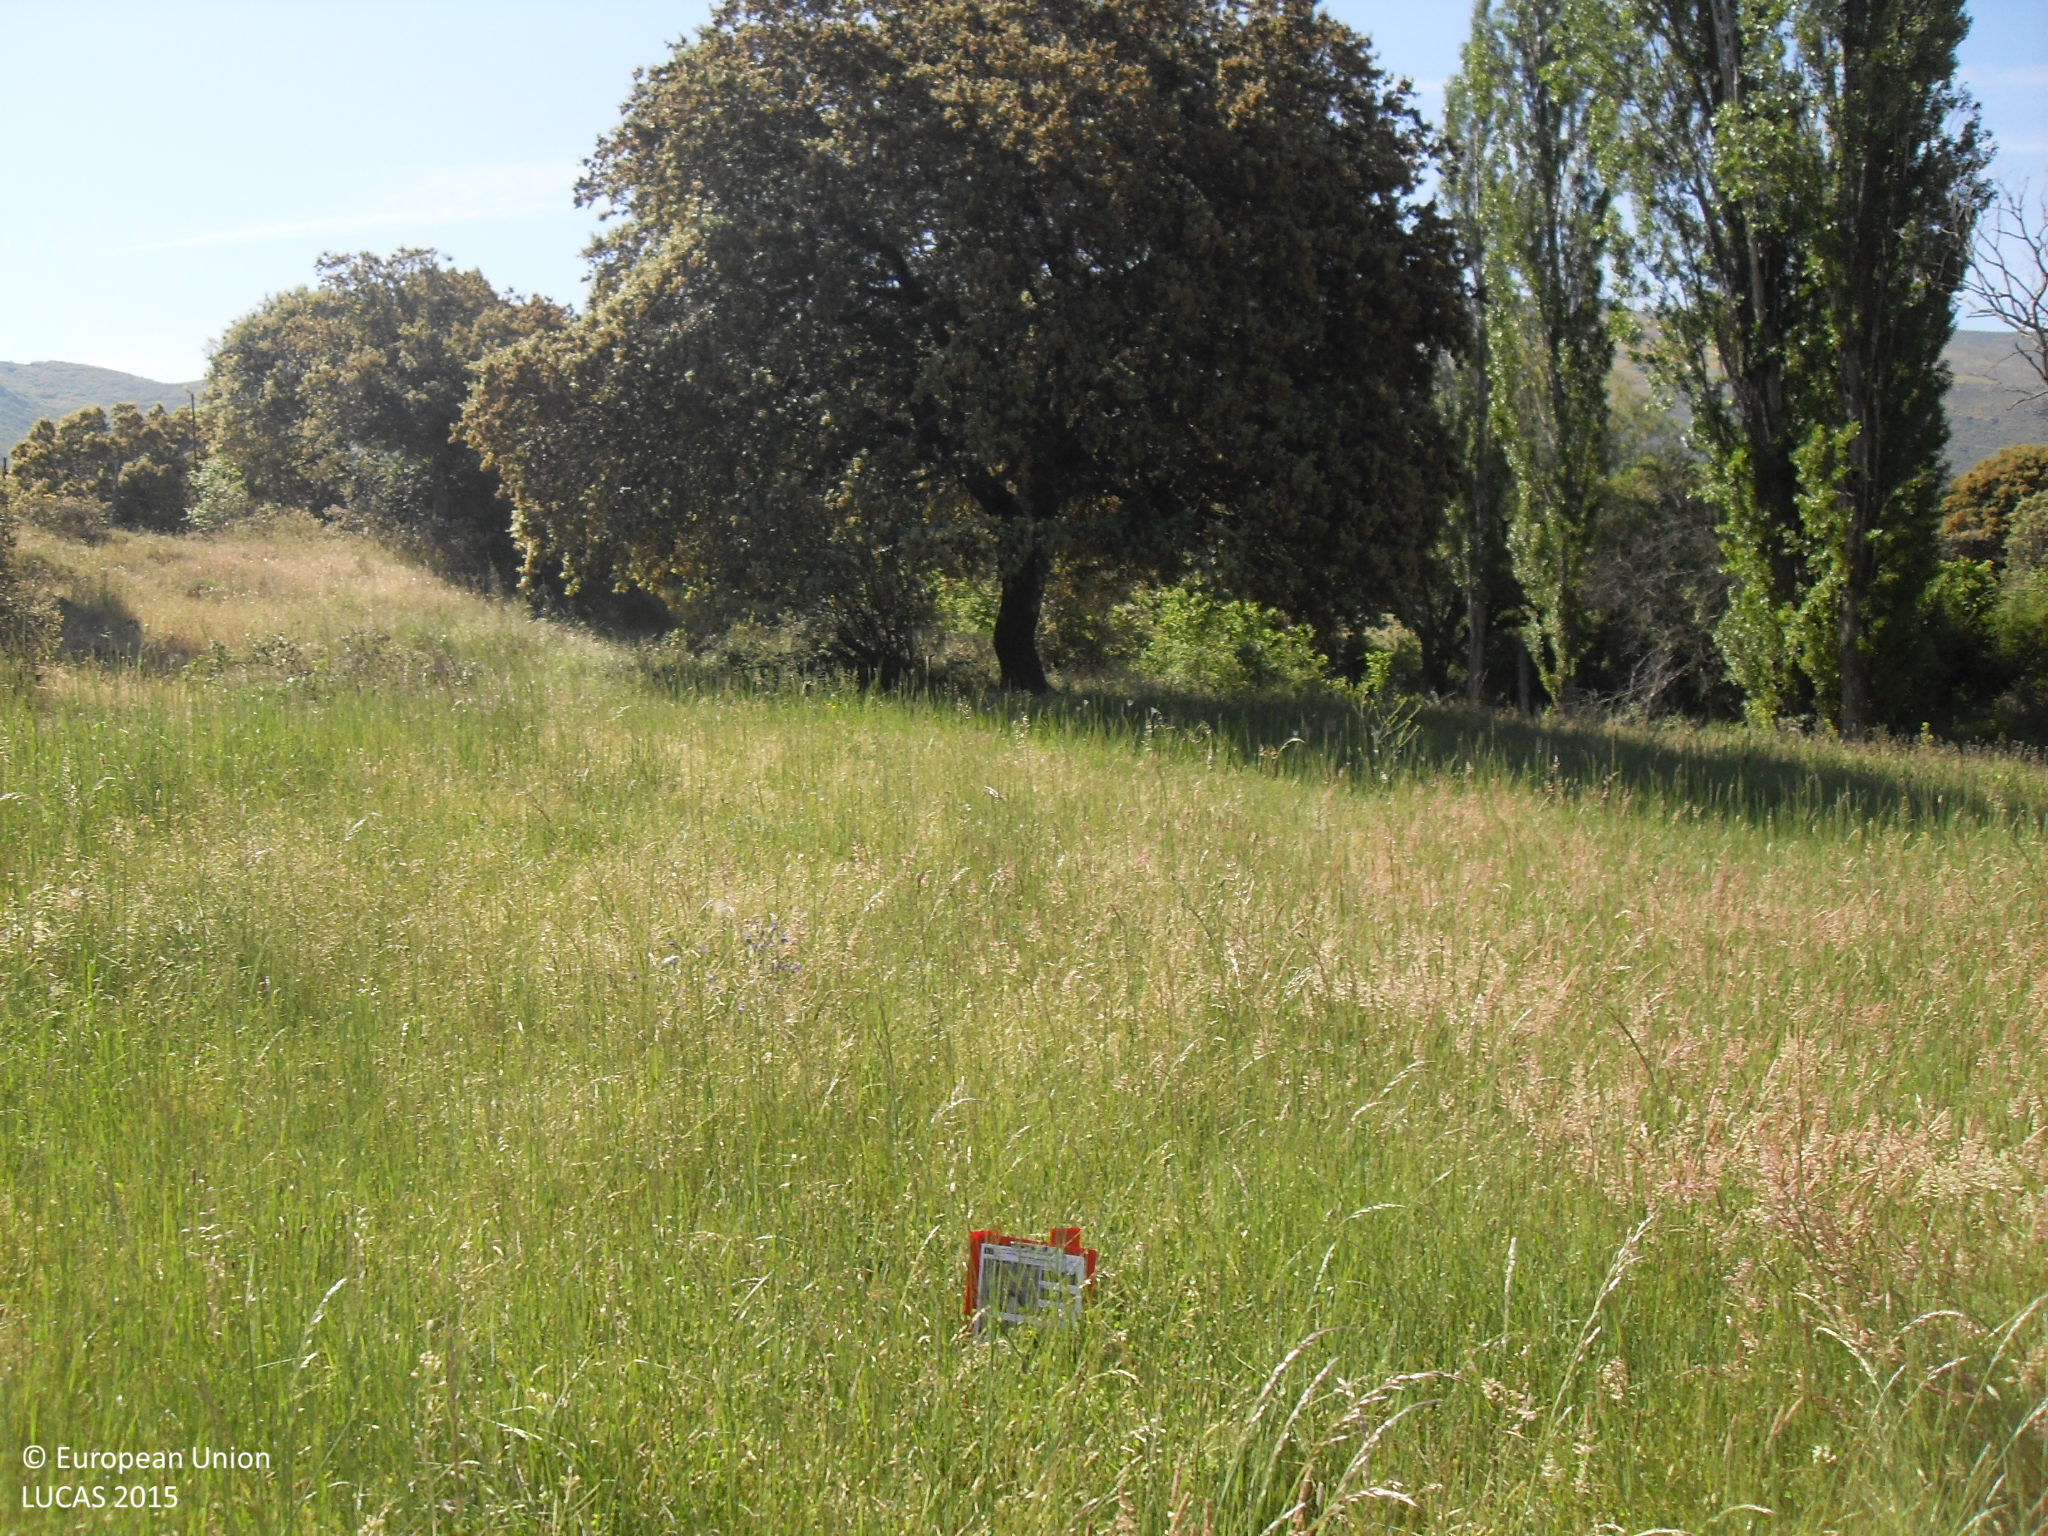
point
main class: Grassland
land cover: Grassland without tree/shrub cover
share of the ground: > 75 %
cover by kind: herbaceous plants 100 %
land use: Agriculture (excluding fallow land and kitchen gardens)
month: May
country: ES
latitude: 40.4967
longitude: -5.2723
